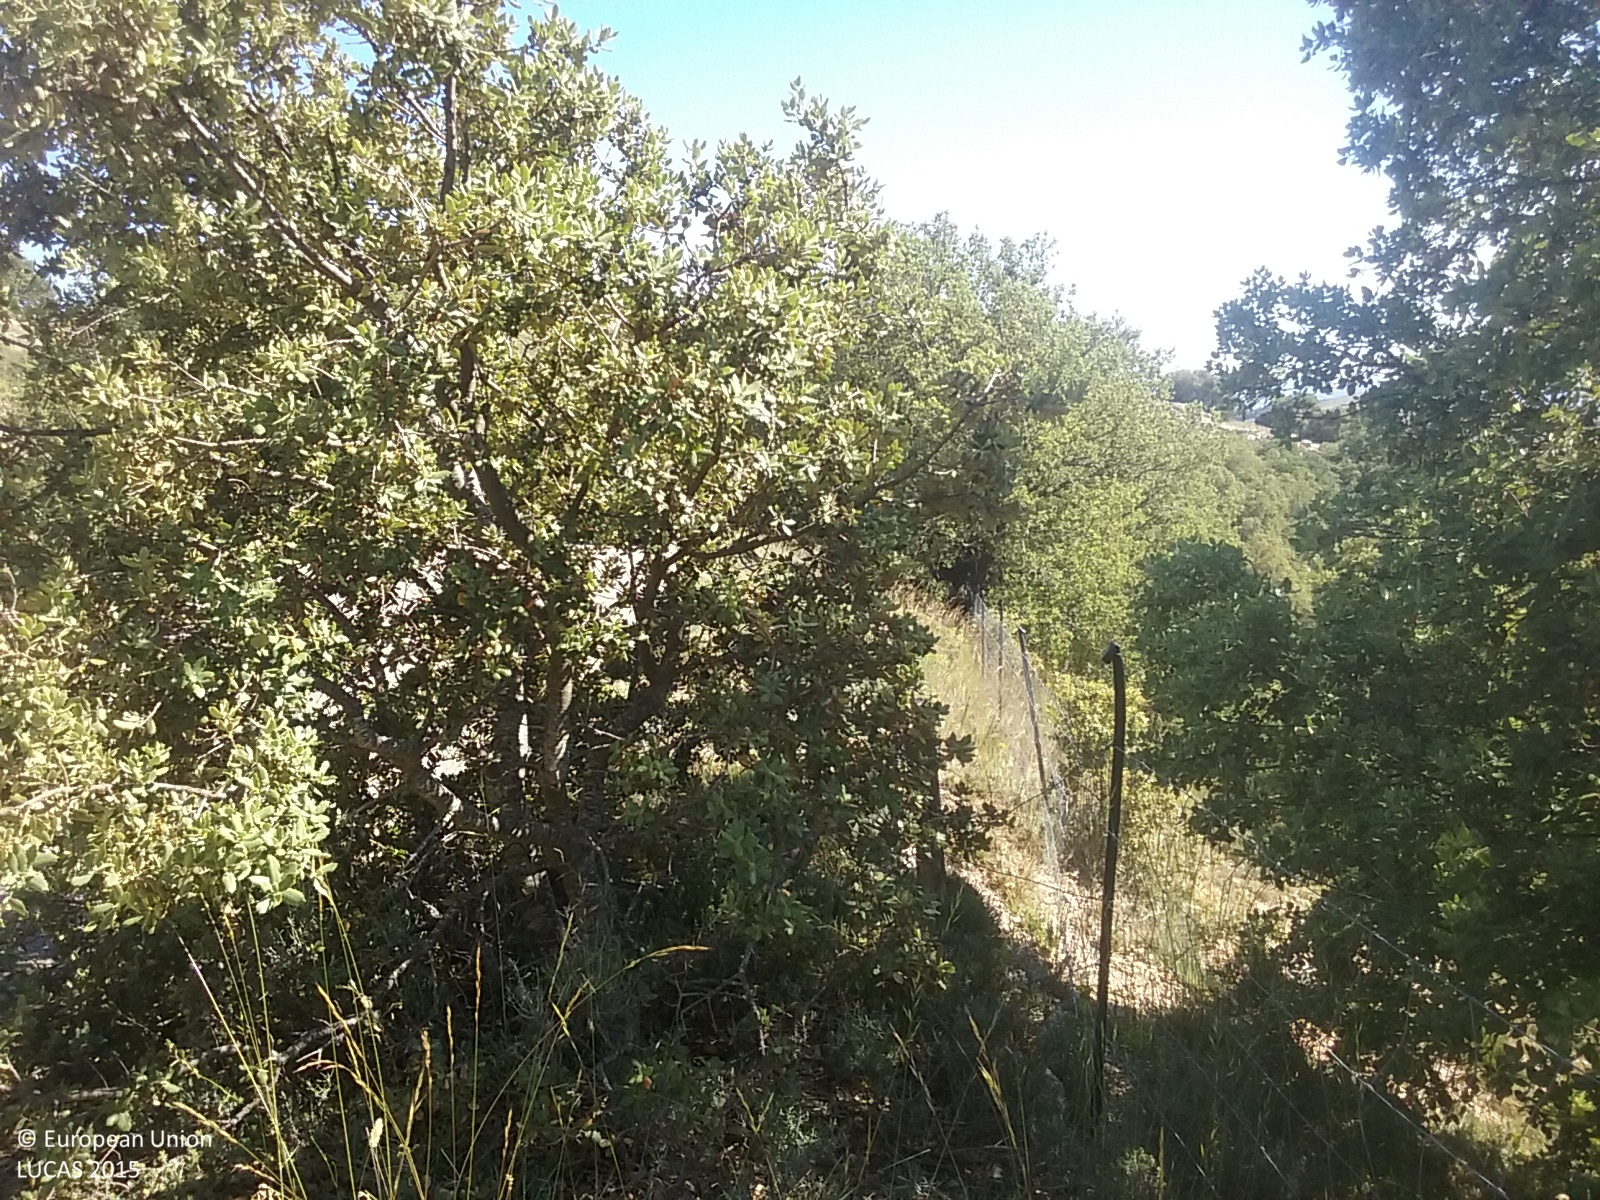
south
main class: Woodland
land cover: Broadleaved woodland
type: broadleaved evergreen forest
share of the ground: 50 - 75 %
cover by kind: broadleaved forest trees 60 %, shrubs 20 %, herbaceous plants 10 %, unconsolidated bare surface 10 %
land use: Forestry
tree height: < 5 m
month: June
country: ES
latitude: 40.6584
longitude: -0.0728
